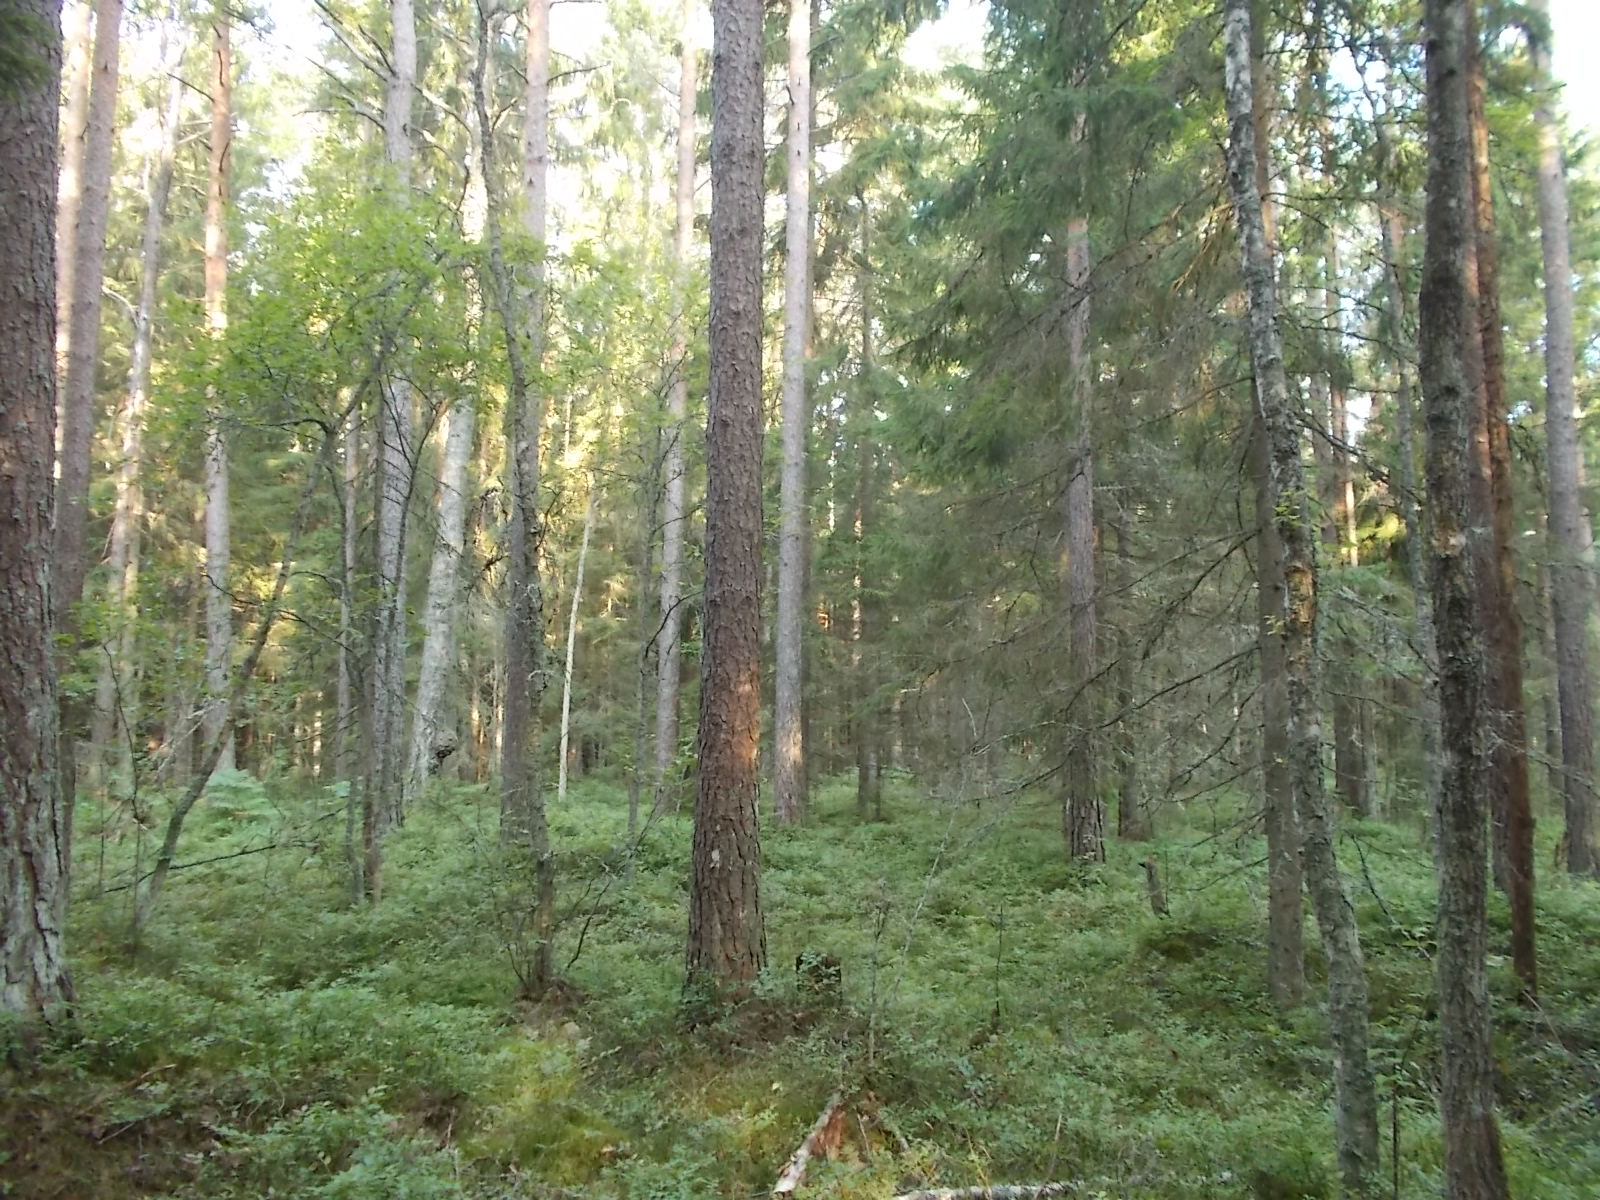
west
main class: Woodland
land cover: Other coniferous woodland
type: hemiboreal forest and nemoral coniferous forest and mixed broadleaved-coniferous forest
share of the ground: 50 - 75 %
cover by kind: coniferous forest trees 65 %, shrubs 10 %, herbaceous plants 10 %, lichens and mosses 10 %, broadleaved forest trees 5 %
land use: Forestry
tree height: > 5 m
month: August
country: LV
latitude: 57.0511
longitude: 21.4973
